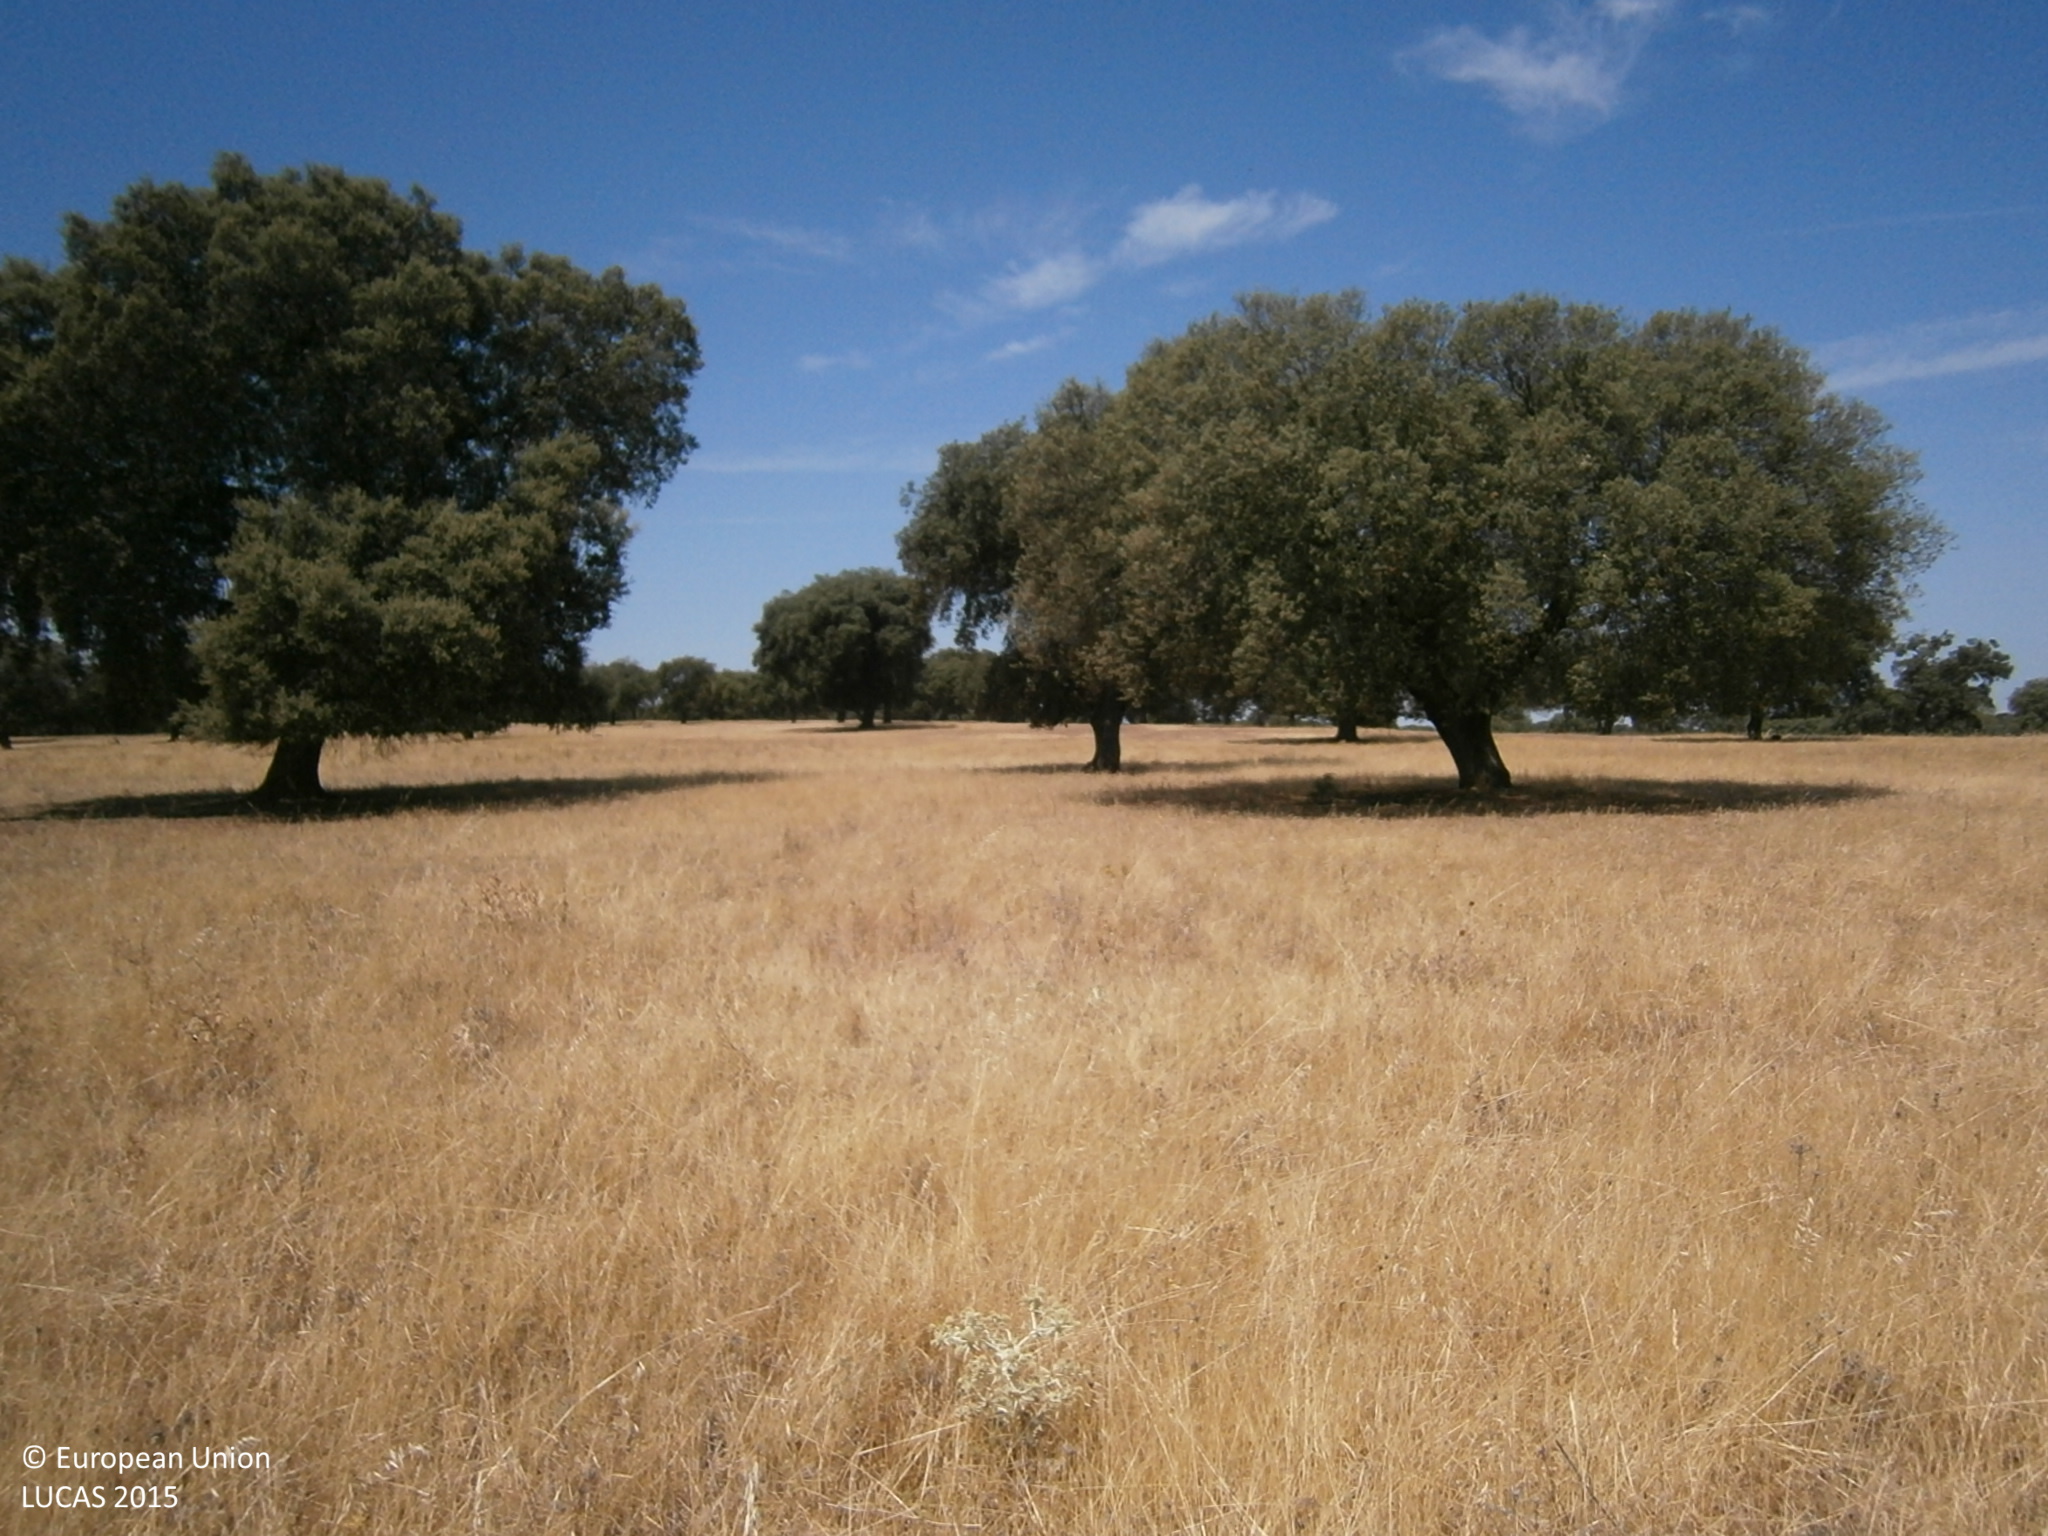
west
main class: Grassland
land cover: Grassland with sparse tree/shrub cover
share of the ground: > 75 %
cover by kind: herbaceous plants 90 %, broadleaved forest trees 5 %, unconsolidated bare surface 5 %
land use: Agriculture (excluding fallow land and kitchen gardens)
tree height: > 5 m
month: July
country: ES
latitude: 38.9878
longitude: -6.8200
